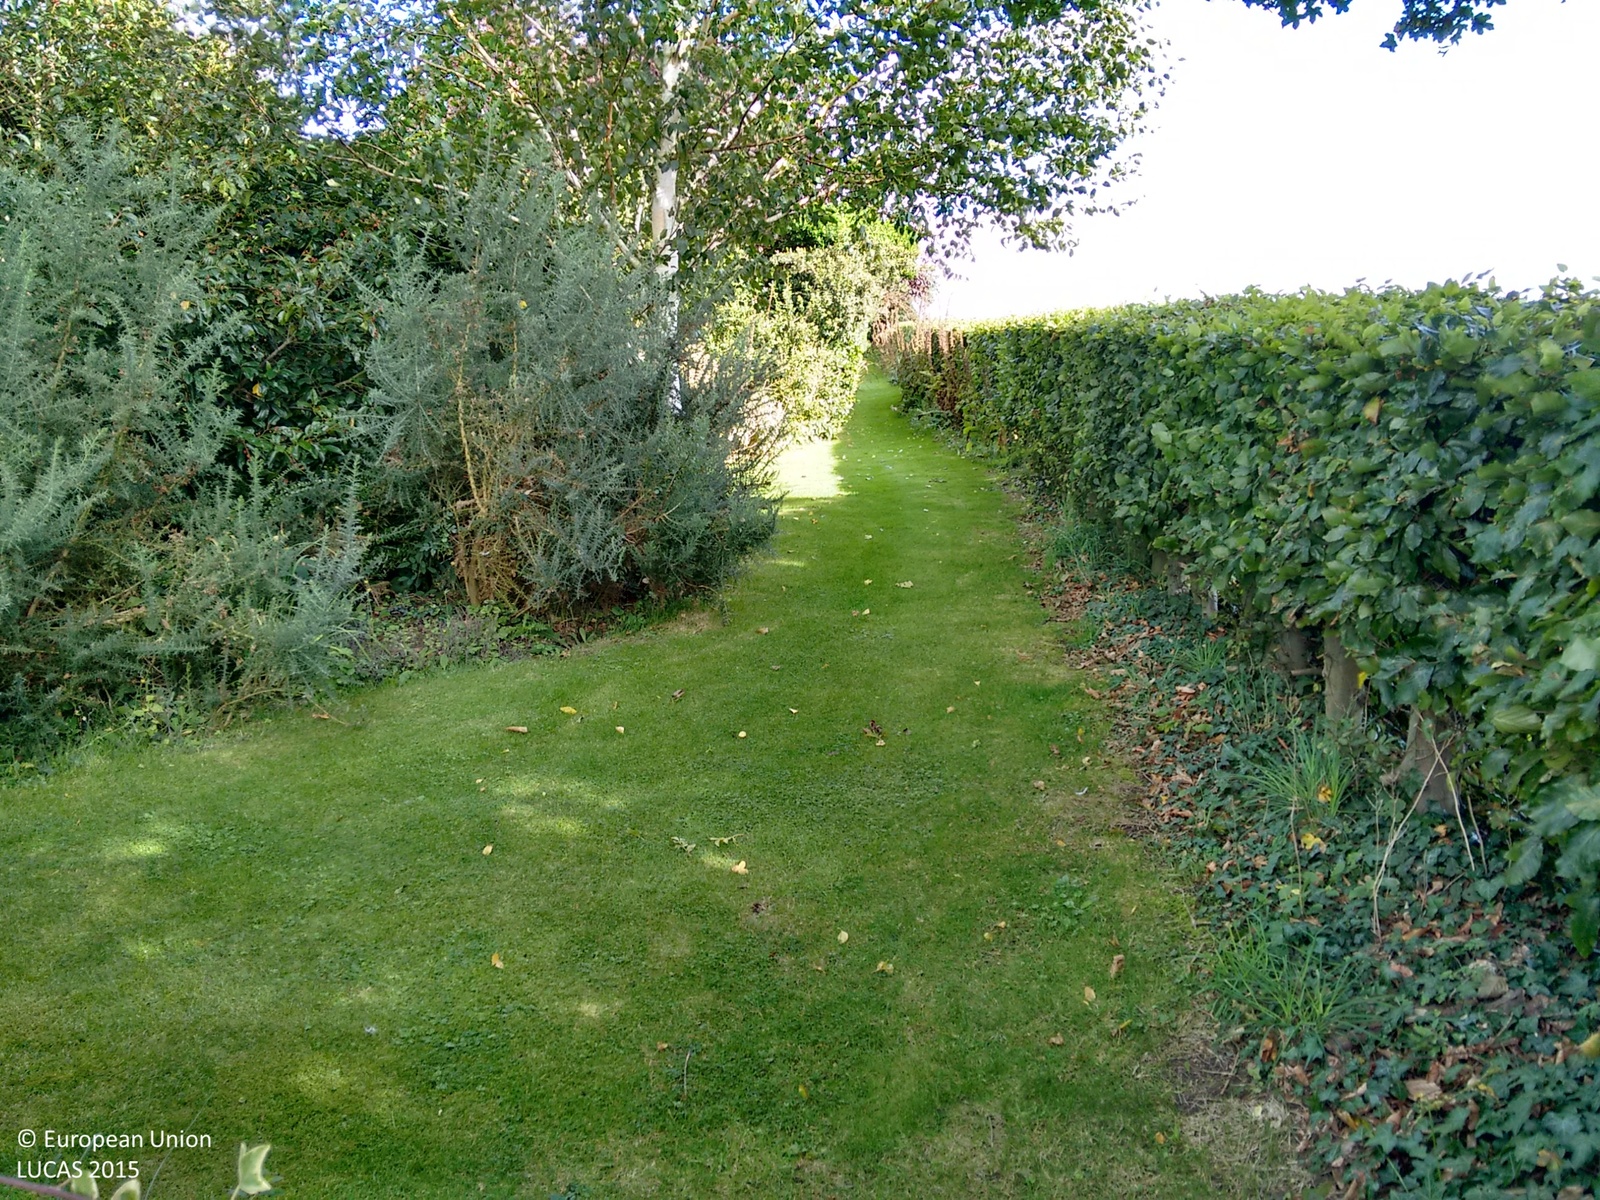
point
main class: Grassland
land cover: Grassland with sparse tree/shrub cover
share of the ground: > 75 %
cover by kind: herbaceous plants 95 %, broadleaved forest trees 5 %
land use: Residential
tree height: > 5 m
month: September
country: GB
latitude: 52.8506
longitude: 1.2628
